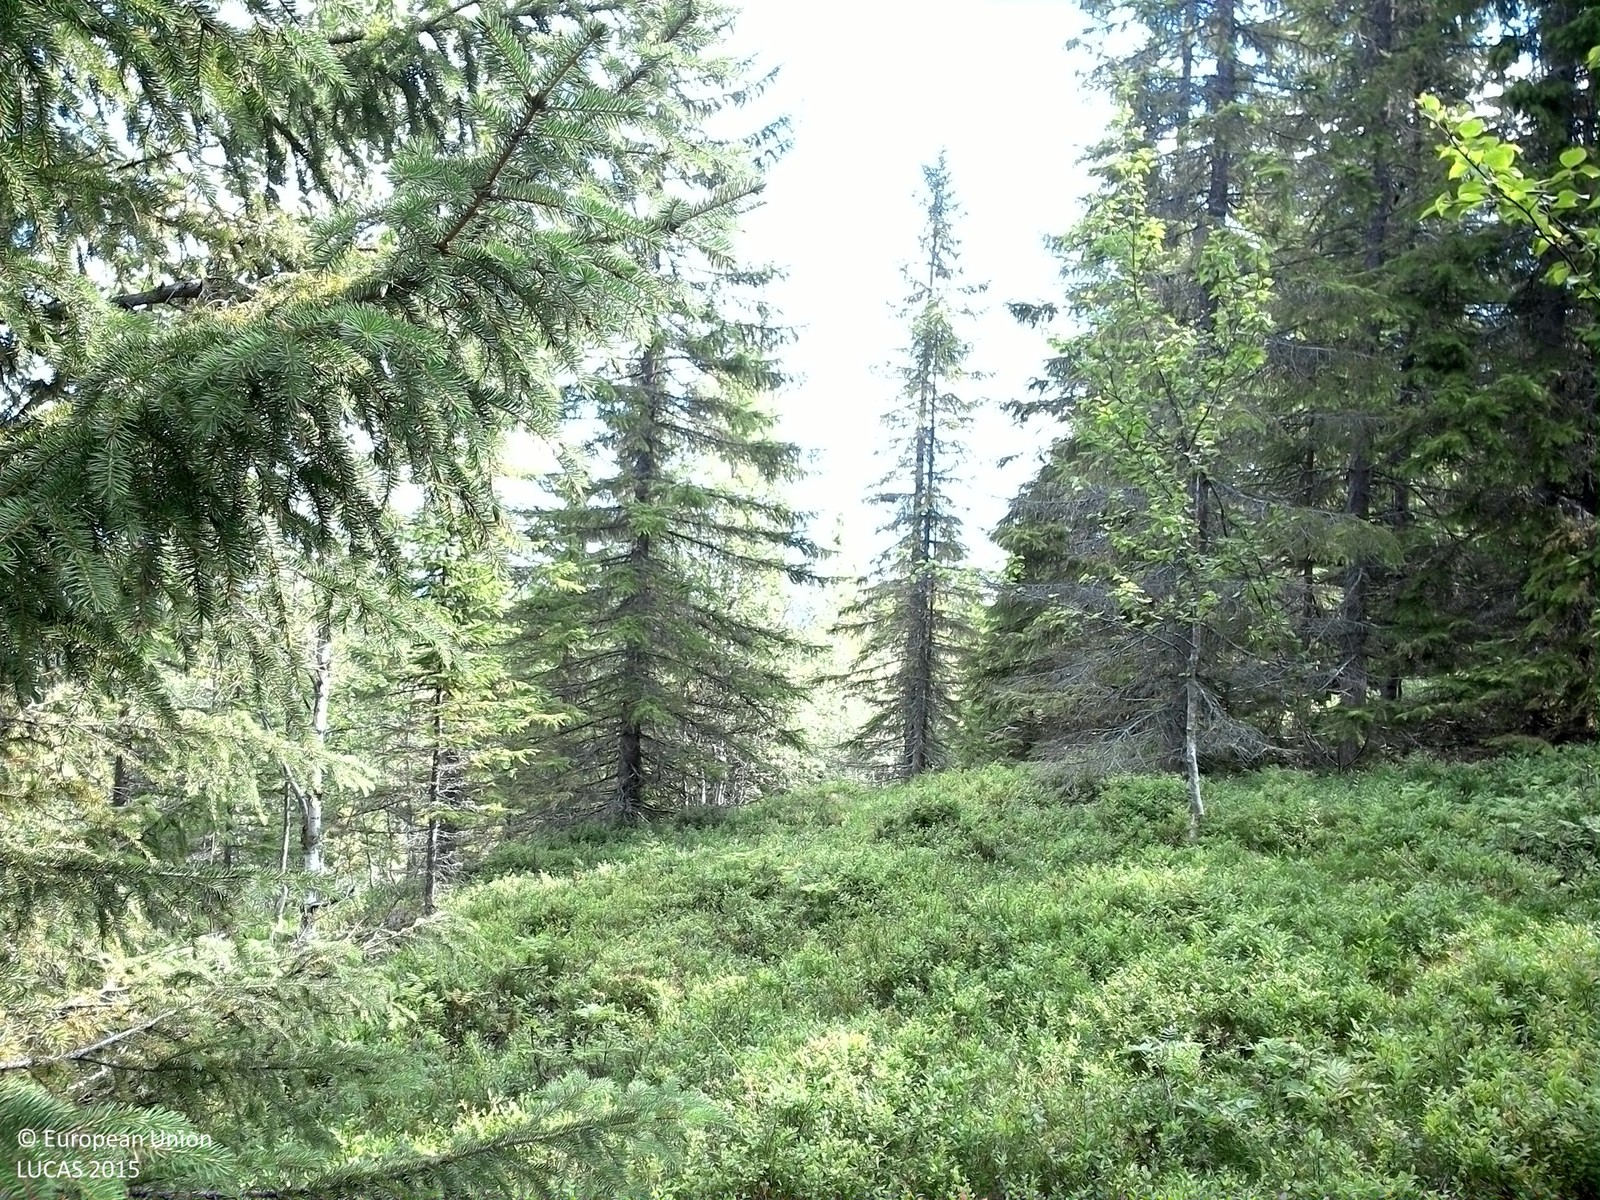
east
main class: Woodland
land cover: Spruce dominated coniferous woodland
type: boreal forest
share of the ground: 50 - 75 %
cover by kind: coniferous forest trees 55 %, shrubs 35 %, broadleaved forest trees 10 %
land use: Forestry
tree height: > 5 m
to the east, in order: Spruce dominated coniferous woodland; Spruce dominated mixed woodland; Spruce dominated coniferous woodland; Spruce dominated mixed woodland; Ditches and canals; Paved roads, cycling and walking lanes; Ditches and canals; Spruce dominated mixed woodland
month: August
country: SE
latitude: 63.6466
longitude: 18.4349
